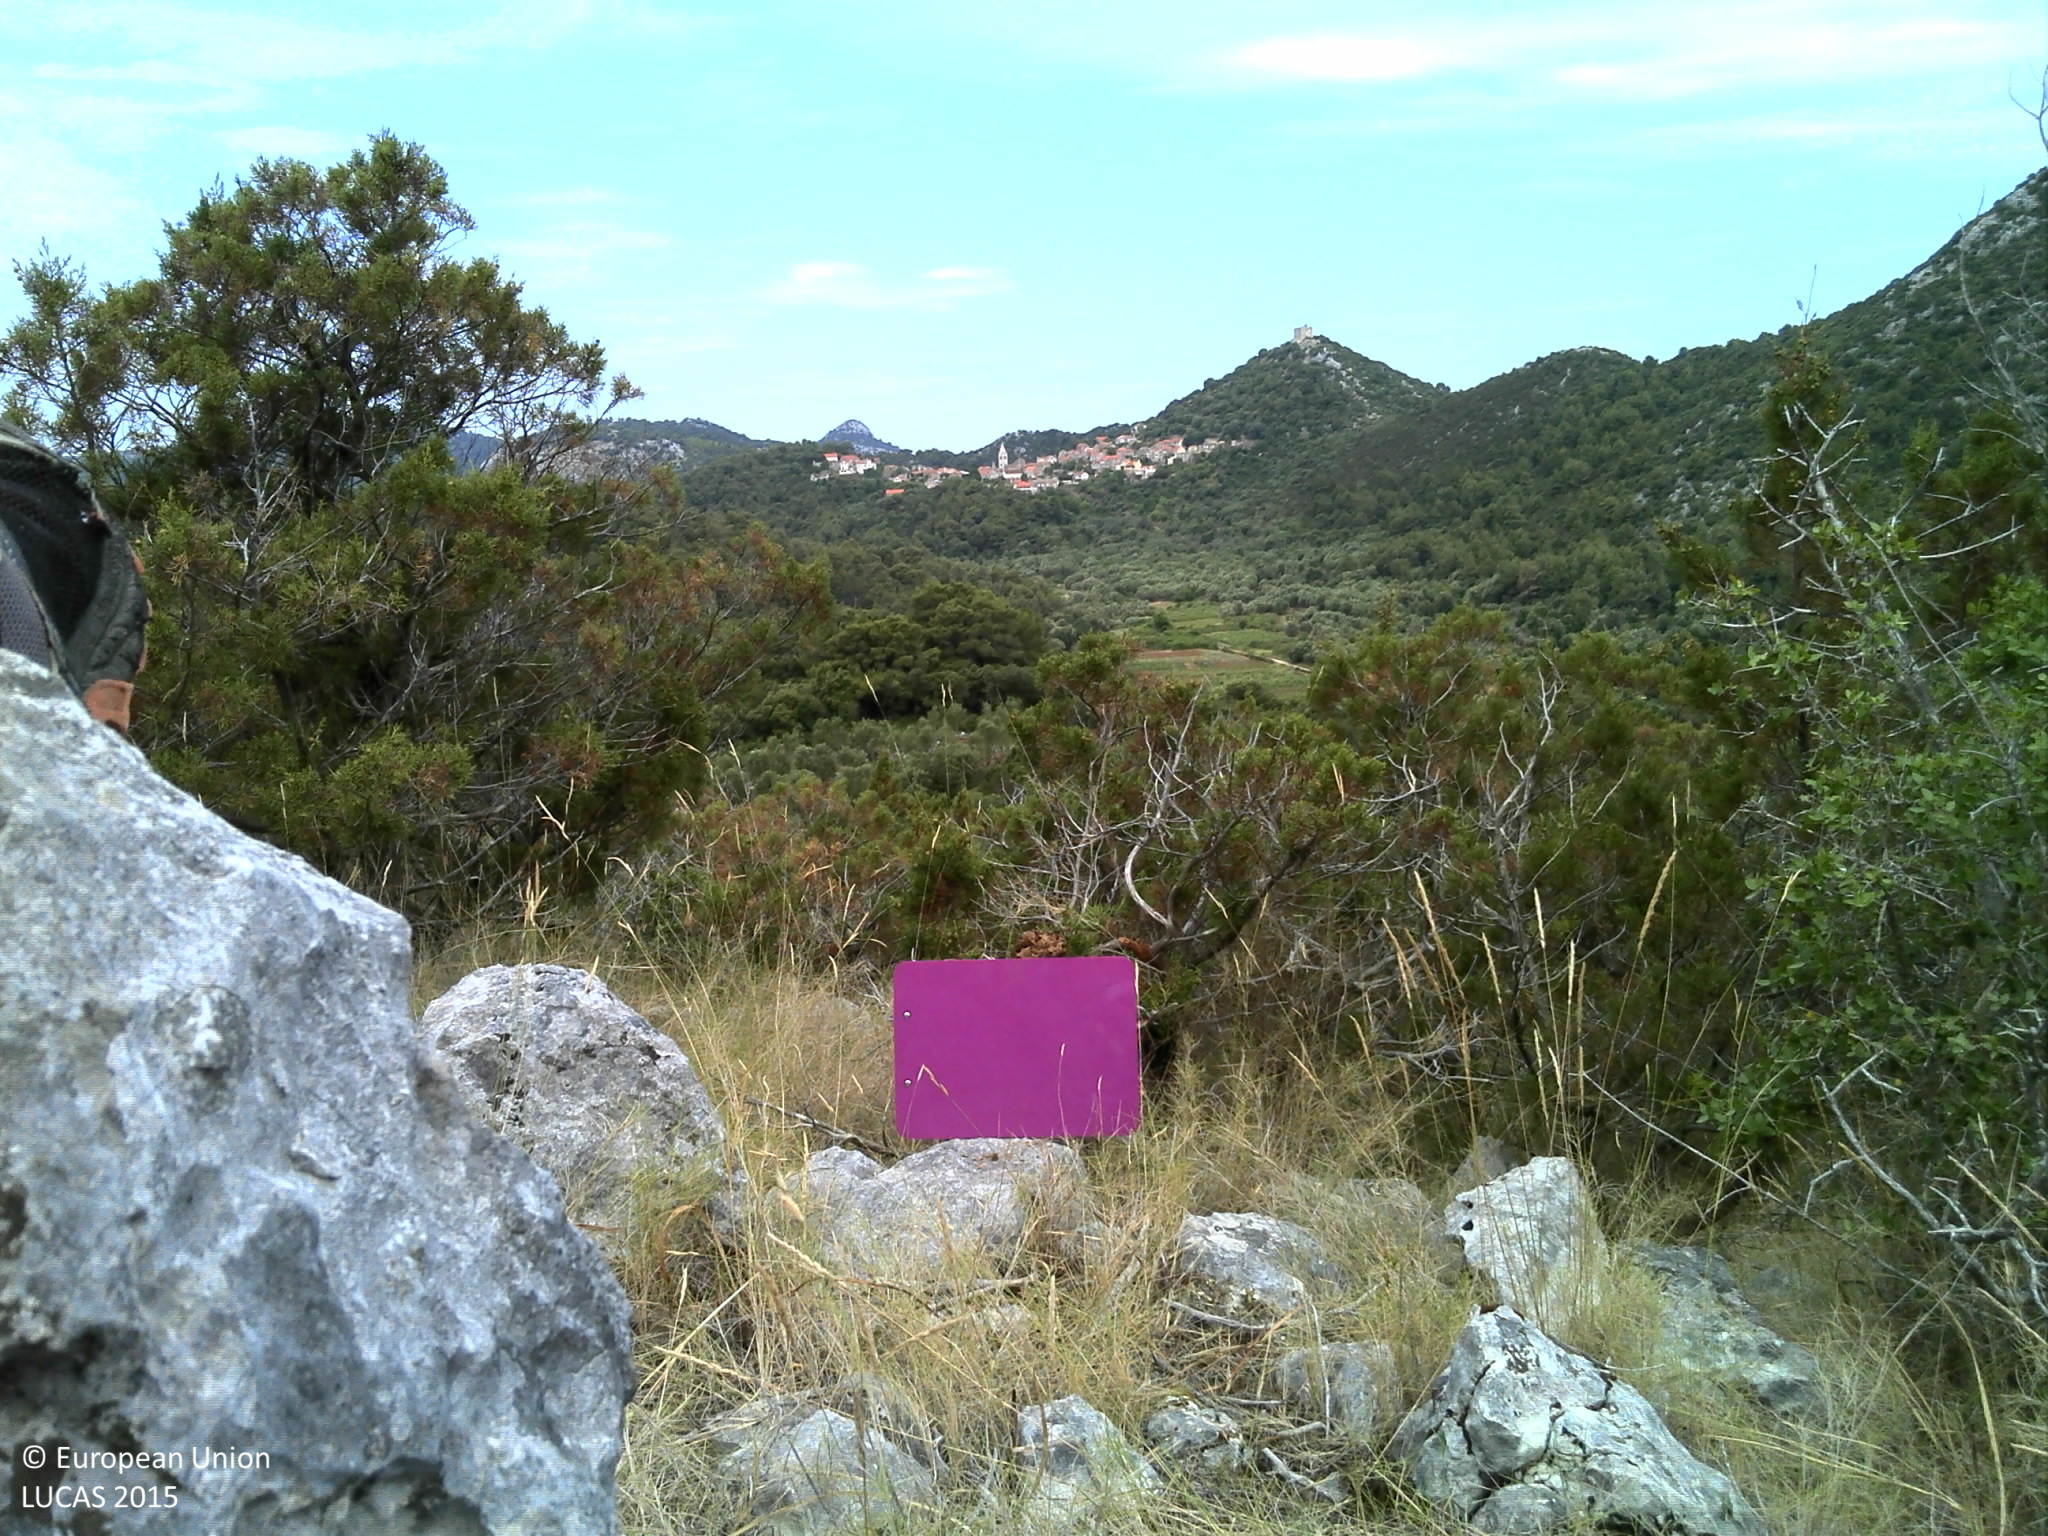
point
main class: Shrubland
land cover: Shrubland with sparse tree cover
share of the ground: > 75 %
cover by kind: shrubs 70 %, herbaceous plants 10 %, unconsolidated bare surface 10 %, coniferous forest trees 5 %, lichens and mosses 5 %
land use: Semi-natural and natural areas not in use
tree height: < 5 m
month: June
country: HR
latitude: 42.7617
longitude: 16.9166
